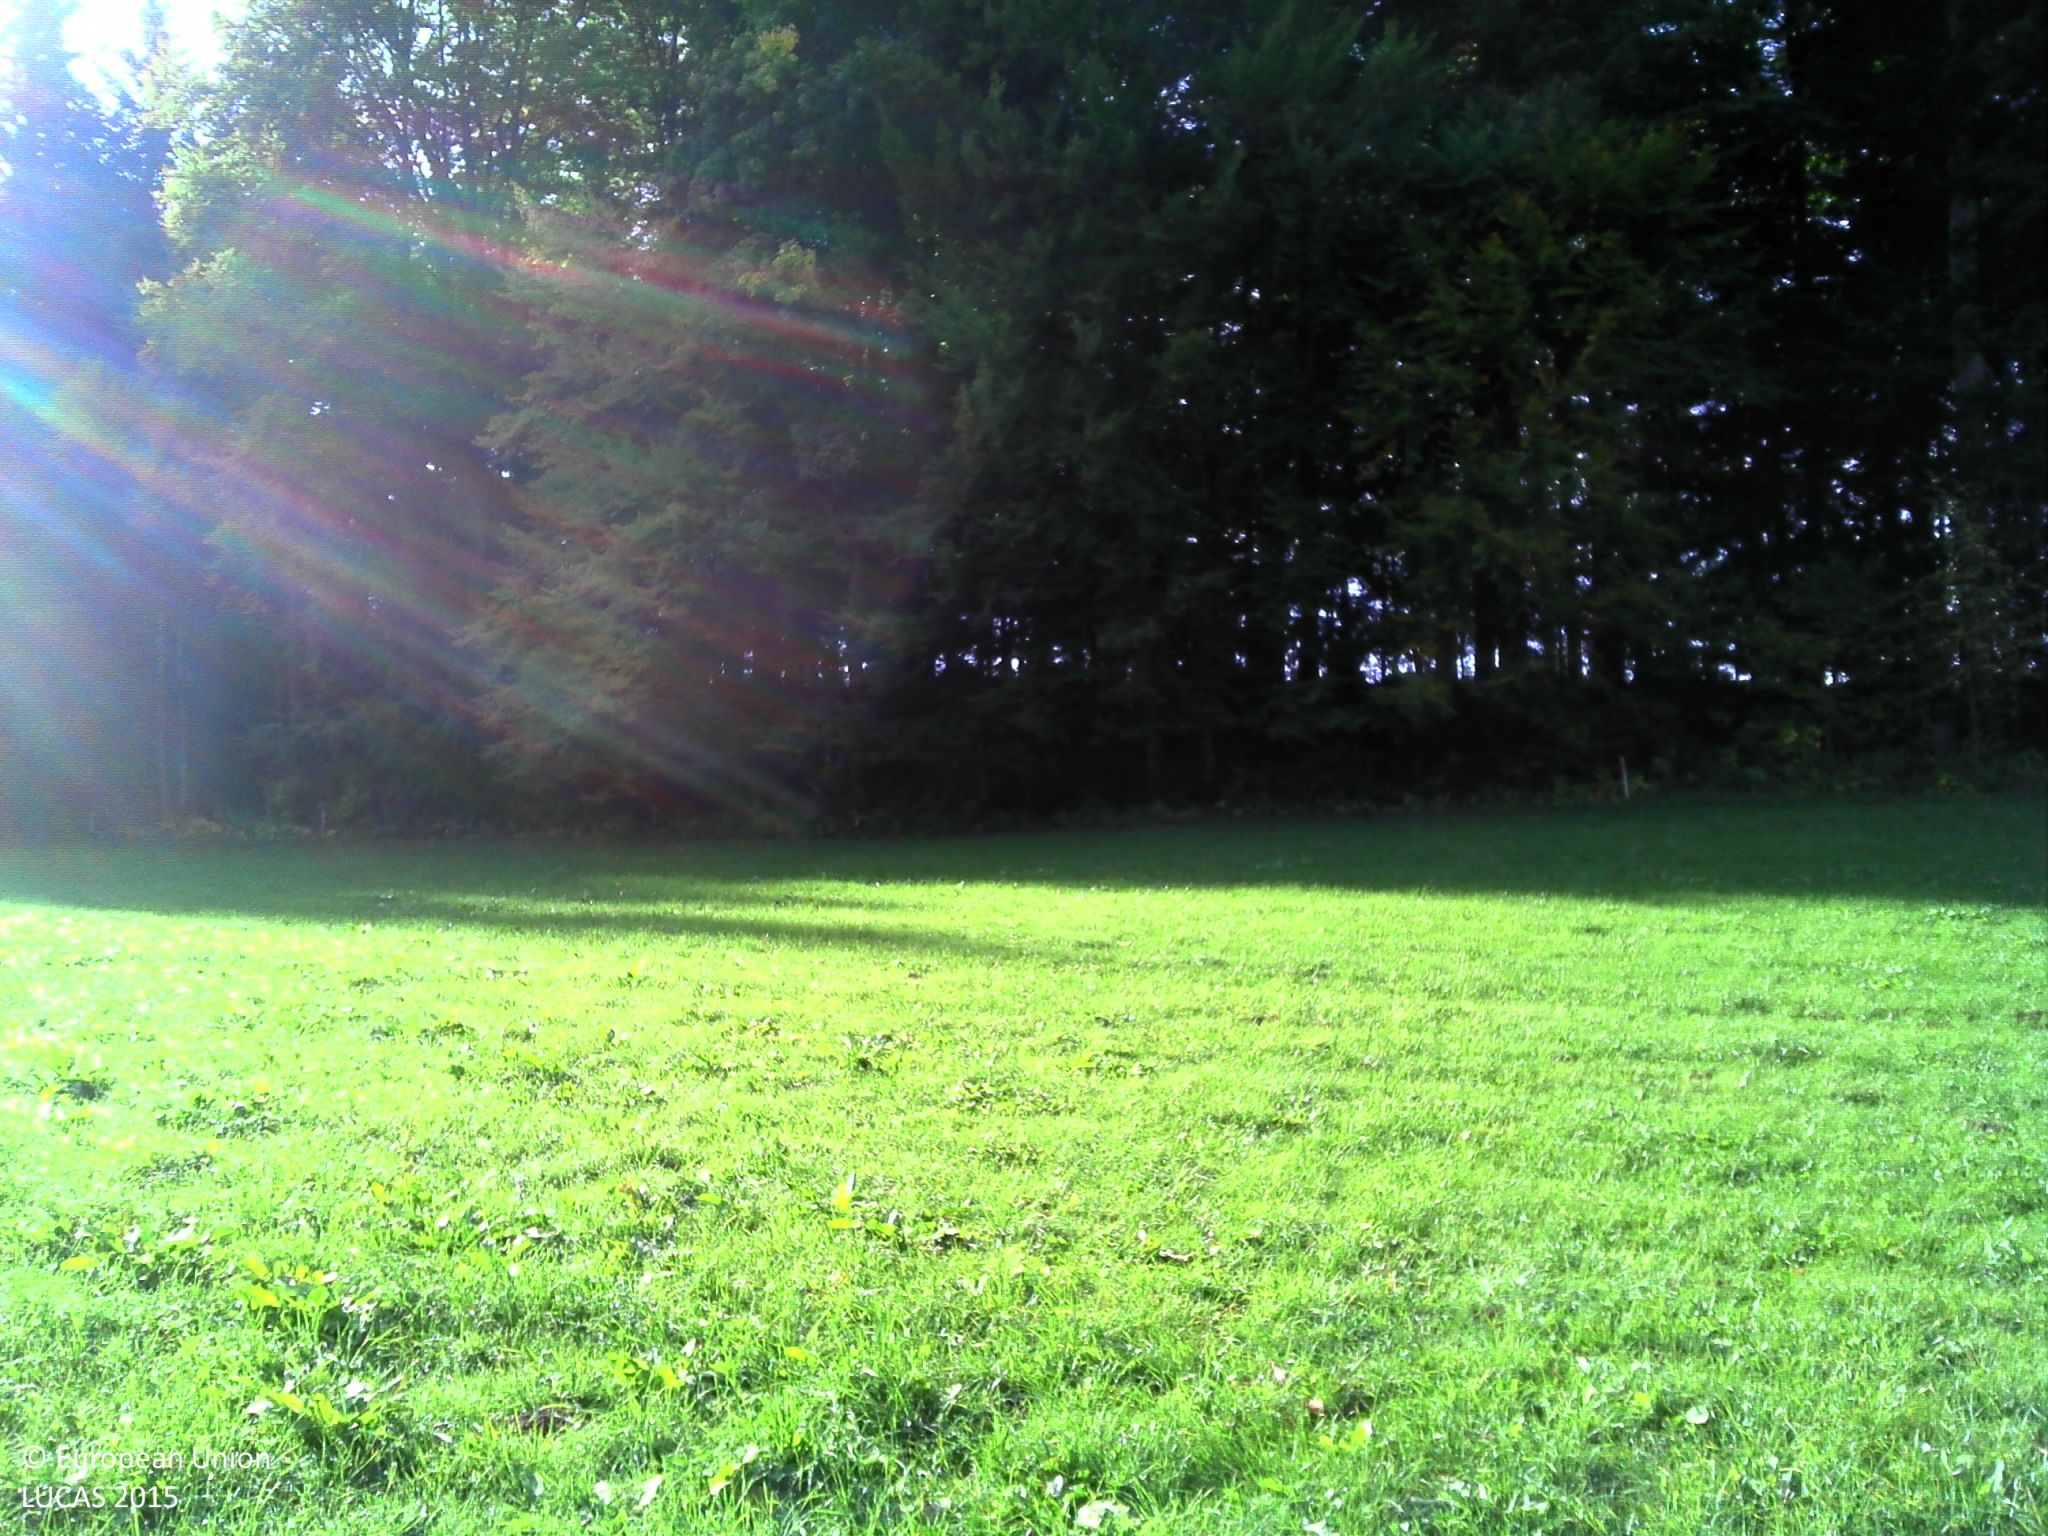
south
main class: Grassland
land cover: Grassland without tree/shrub cover
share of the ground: > 75 %
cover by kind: herbaceous plants 100 %
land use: Agriculture (excluding fallow land and kitchen gardens)
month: October
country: FR
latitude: 47.0642
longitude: 6.3549
